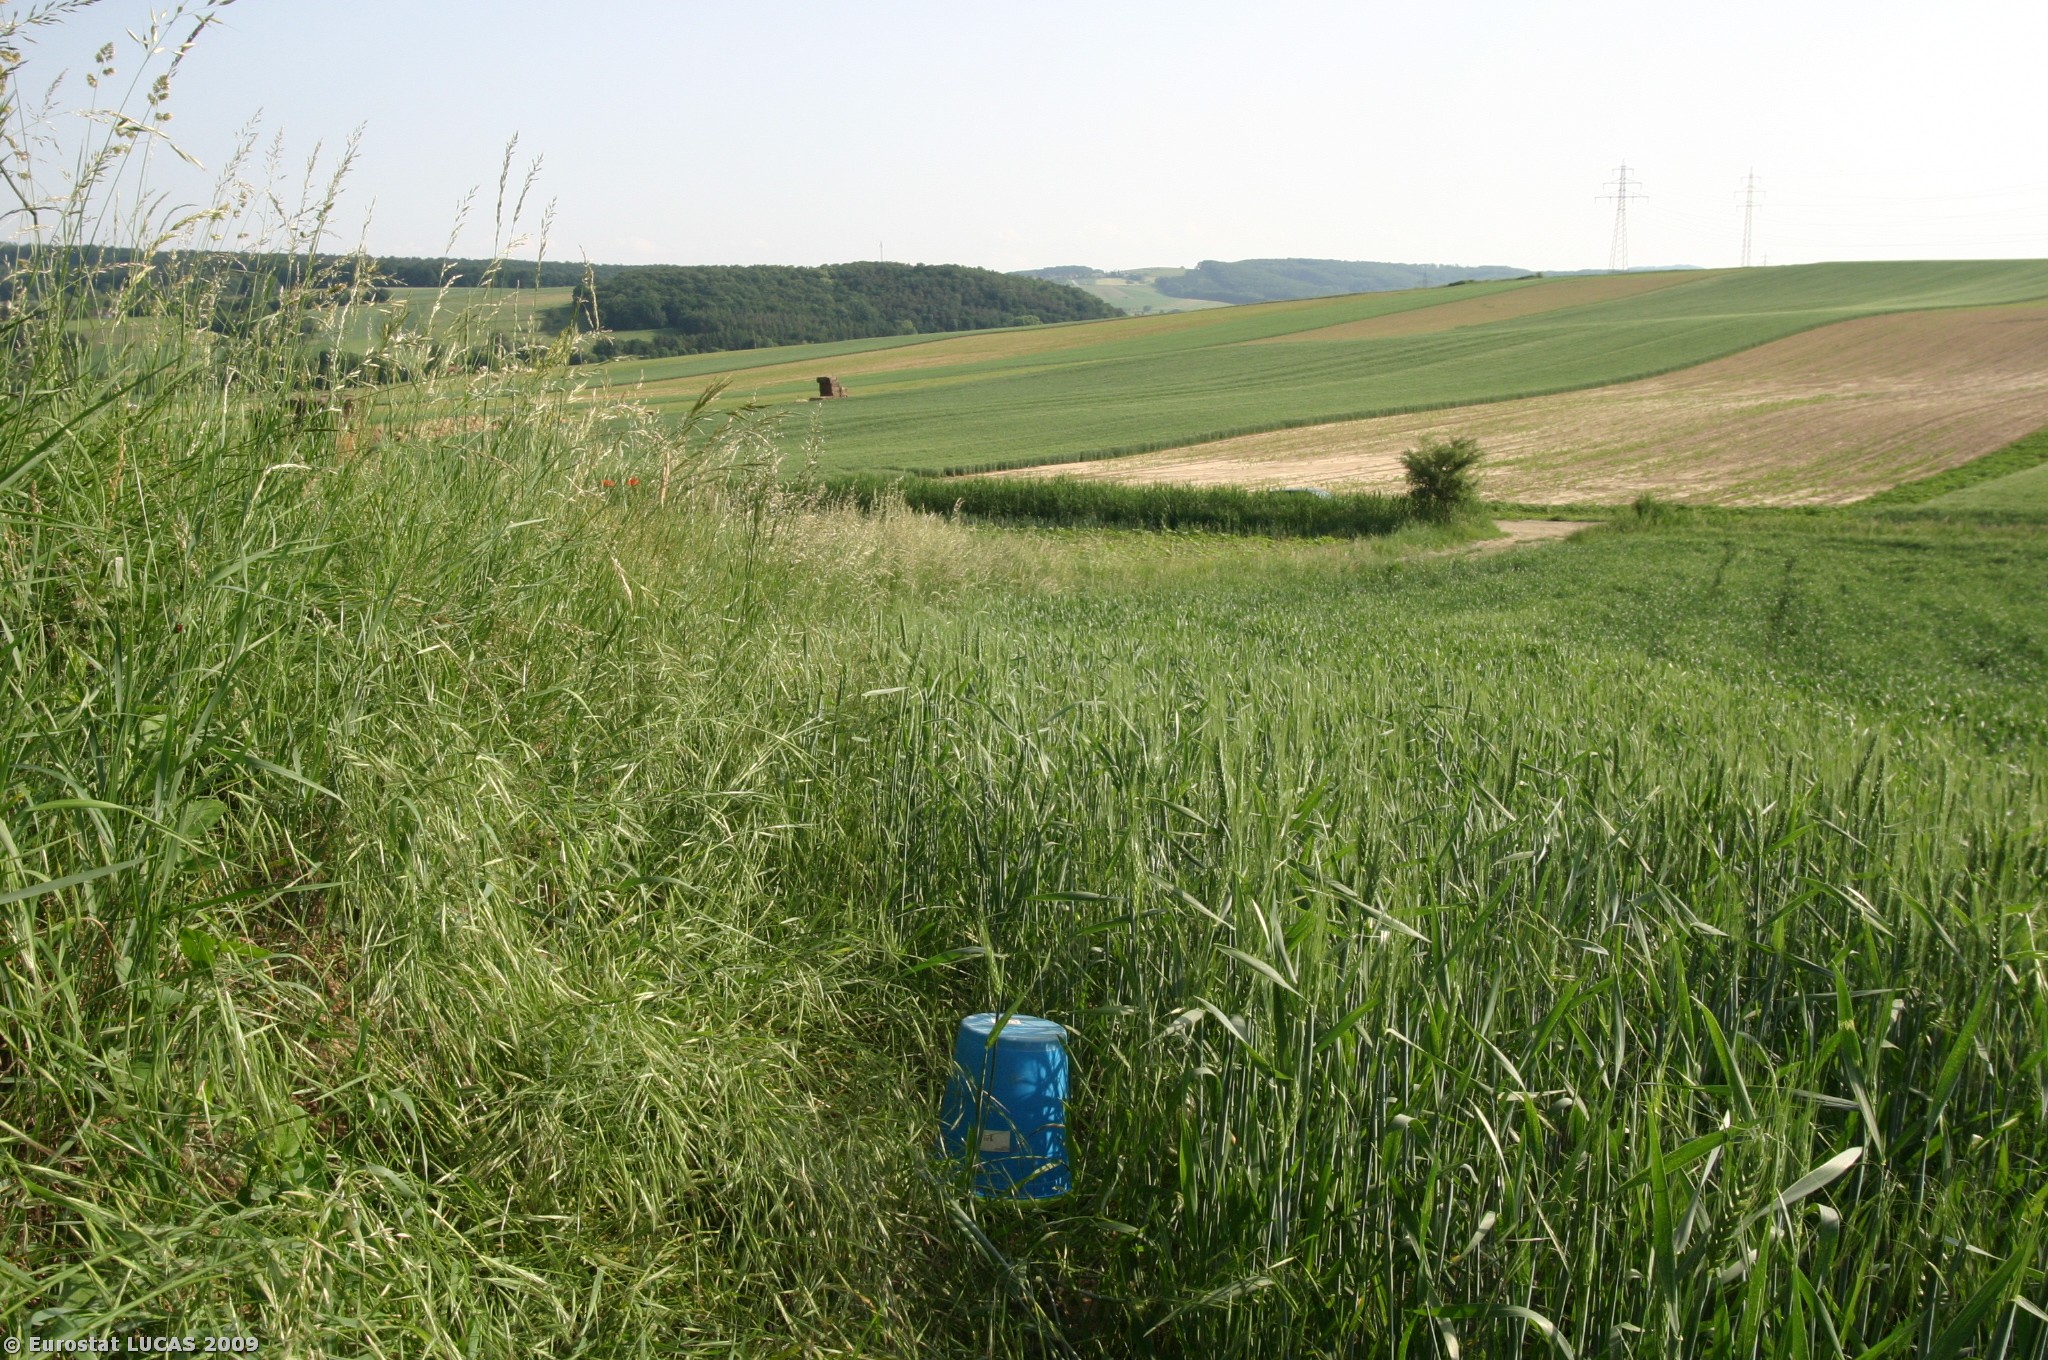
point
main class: Cropland
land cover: Triticale
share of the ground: > 75 %
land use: Agriculture (excluding fallow land and kitchen gardens)
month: May
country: AT
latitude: 48.2408
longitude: 15.9958
